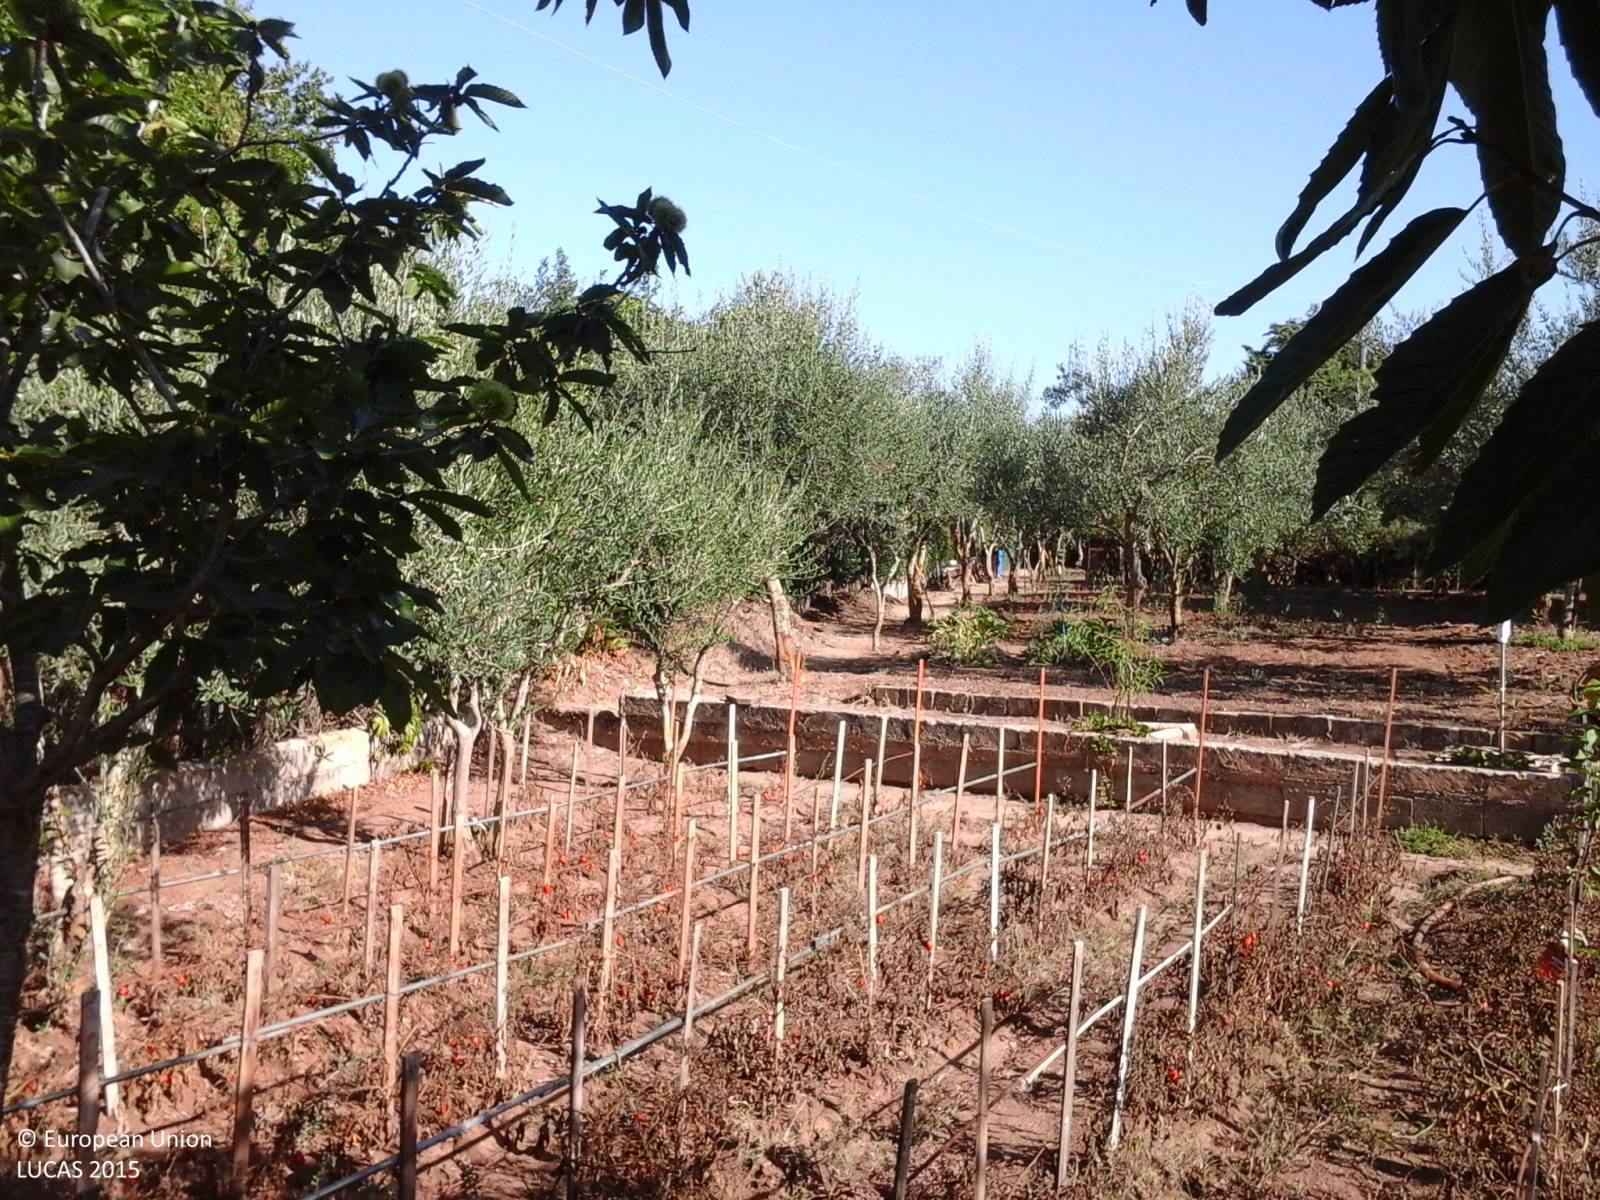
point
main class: Cropland
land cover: Olive groves
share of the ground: < 10 %
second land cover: Tomatoes
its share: < 10 %
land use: Kitchen garden
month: May
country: IT
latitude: 40.7443
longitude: 8.4796
